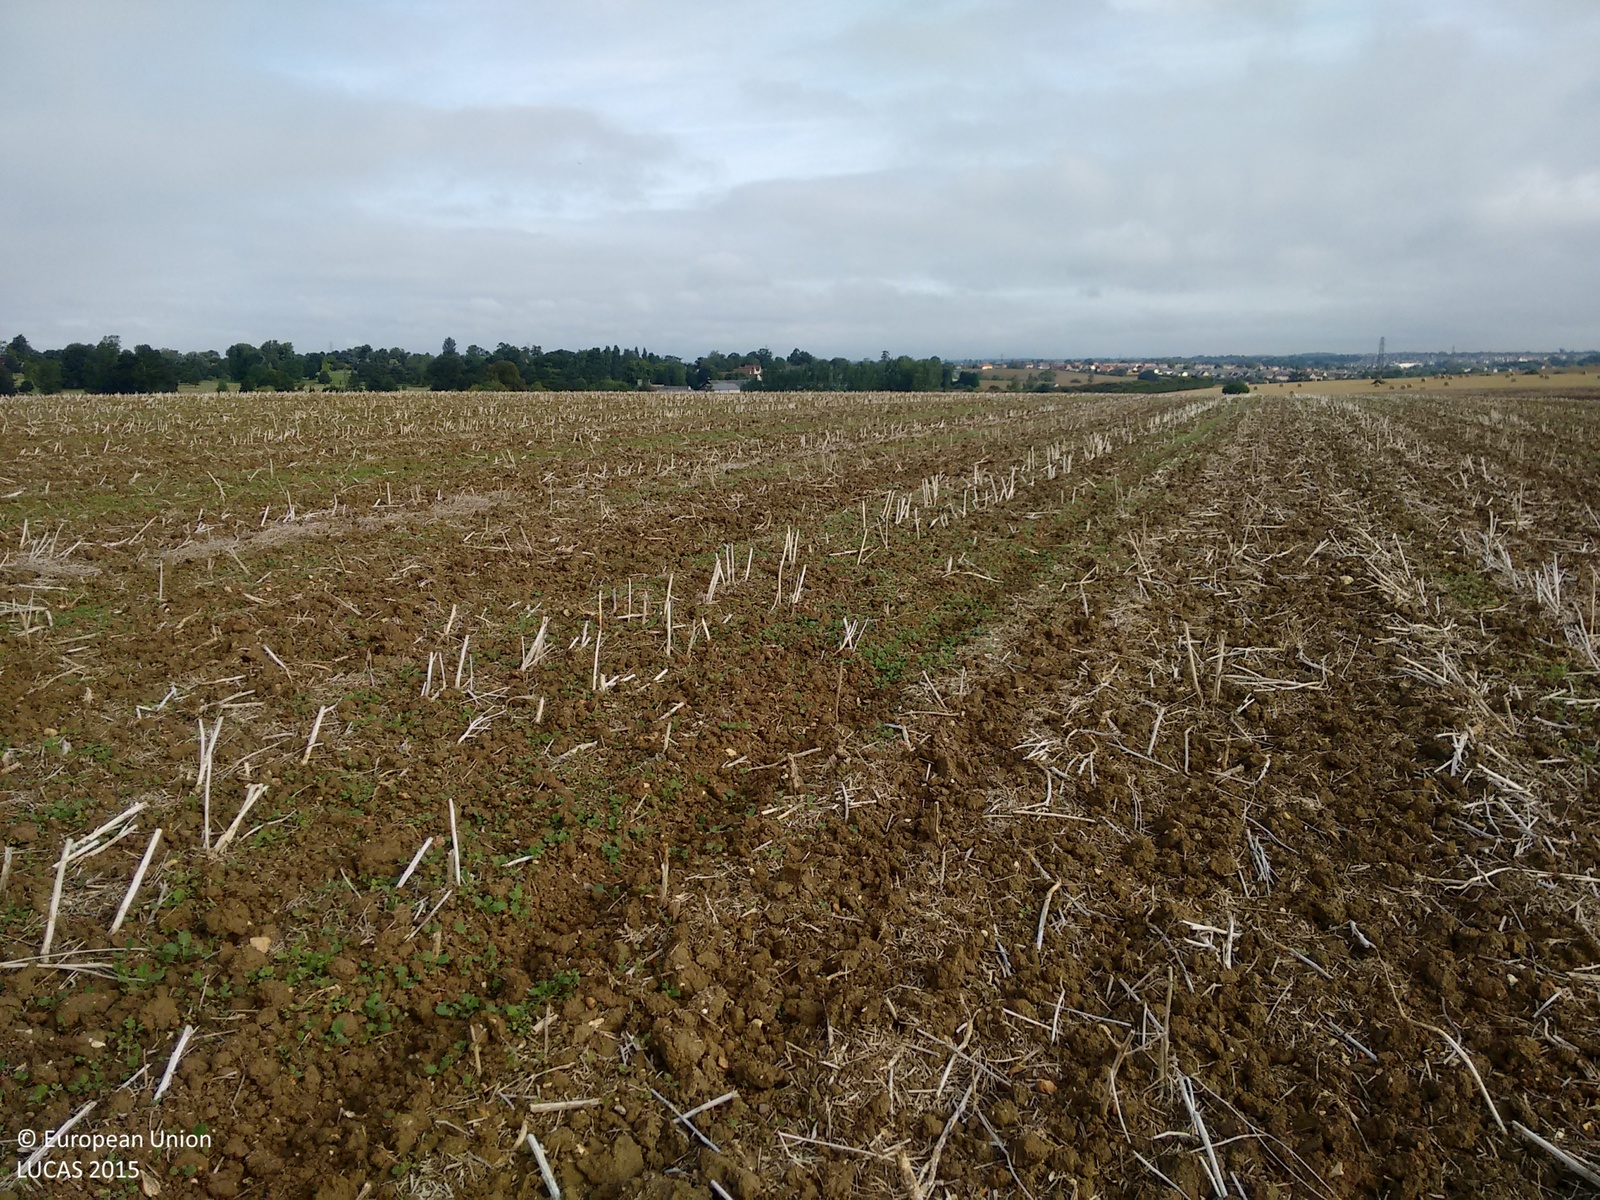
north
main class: Cropland
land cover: Rape and turnip rape
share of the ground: 25 - 50 %
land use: Agriculture (excluding fallow land and kitchen gardens)
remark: Harvested field
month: September
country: GB
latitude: 52.1607
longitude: 0.9864
